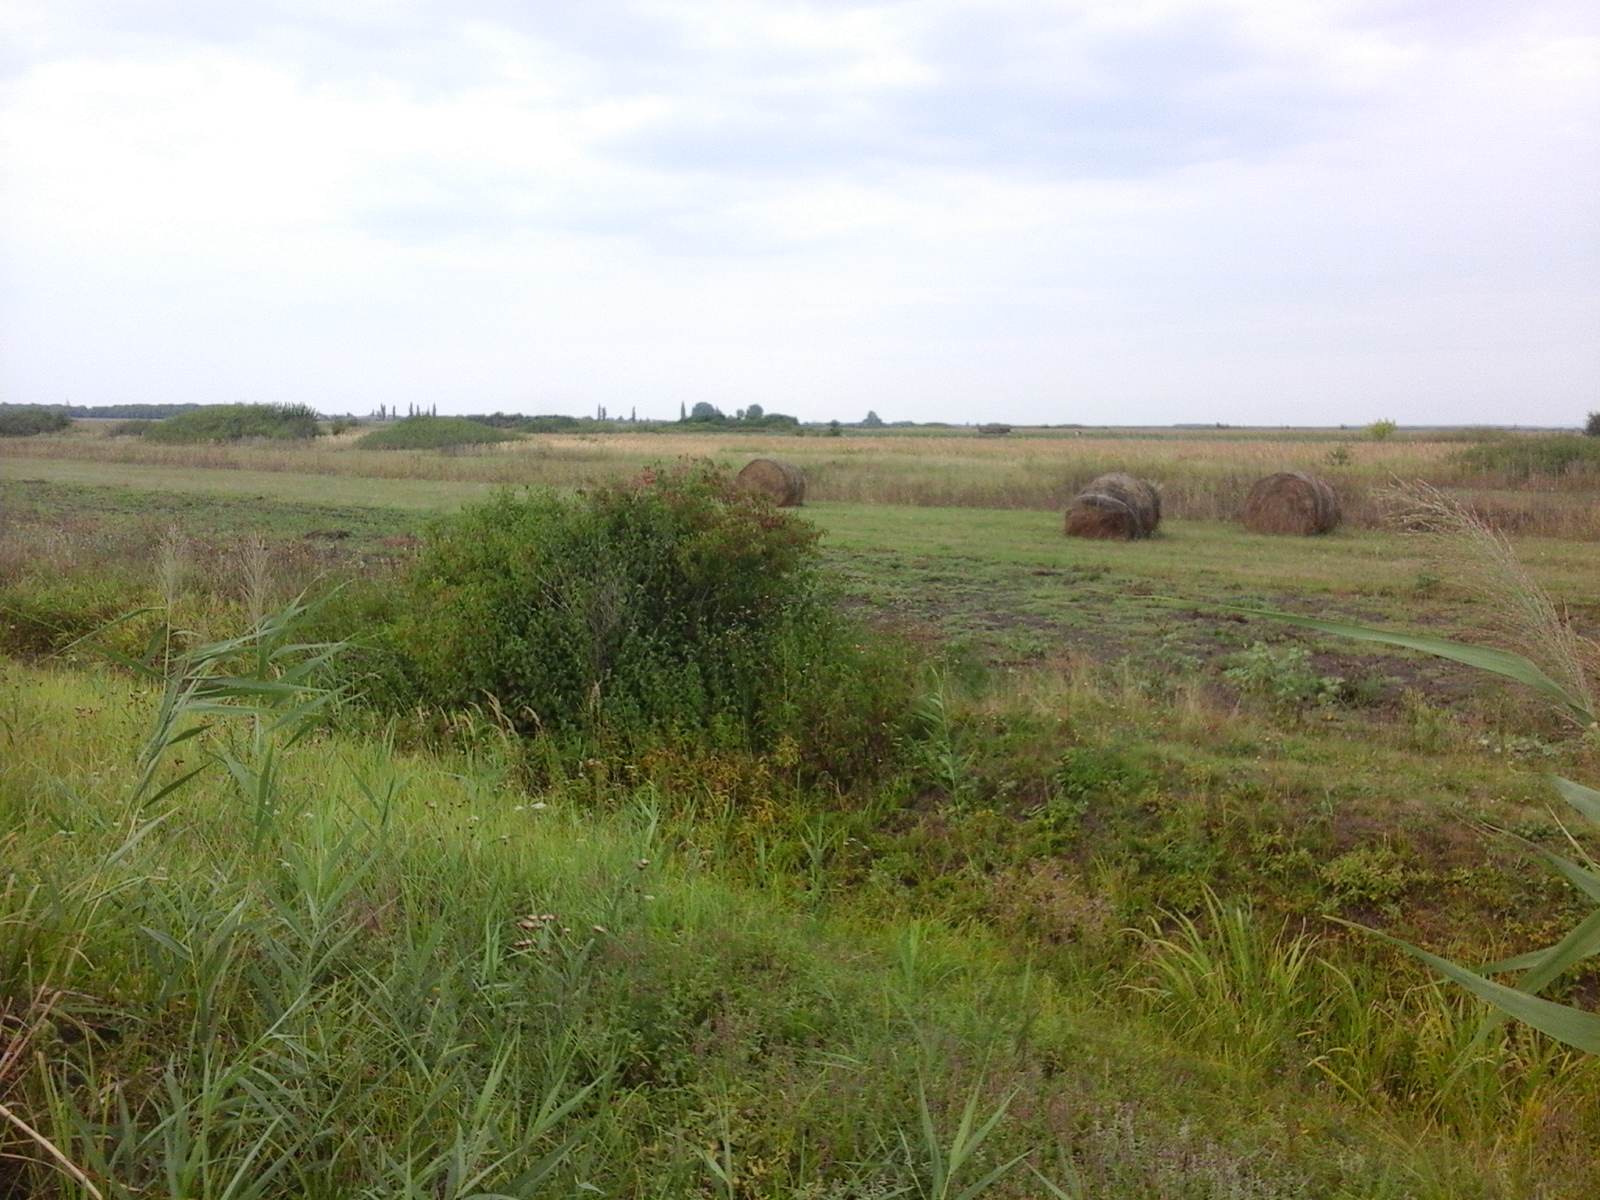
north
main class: Grassland
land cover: Spontaneously vegetated surfaces
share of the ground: > 75 %
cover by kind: herbaceous plants 100 %
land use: Fallow land
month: August
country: RO
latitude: 46.3852
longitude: 21.6507
